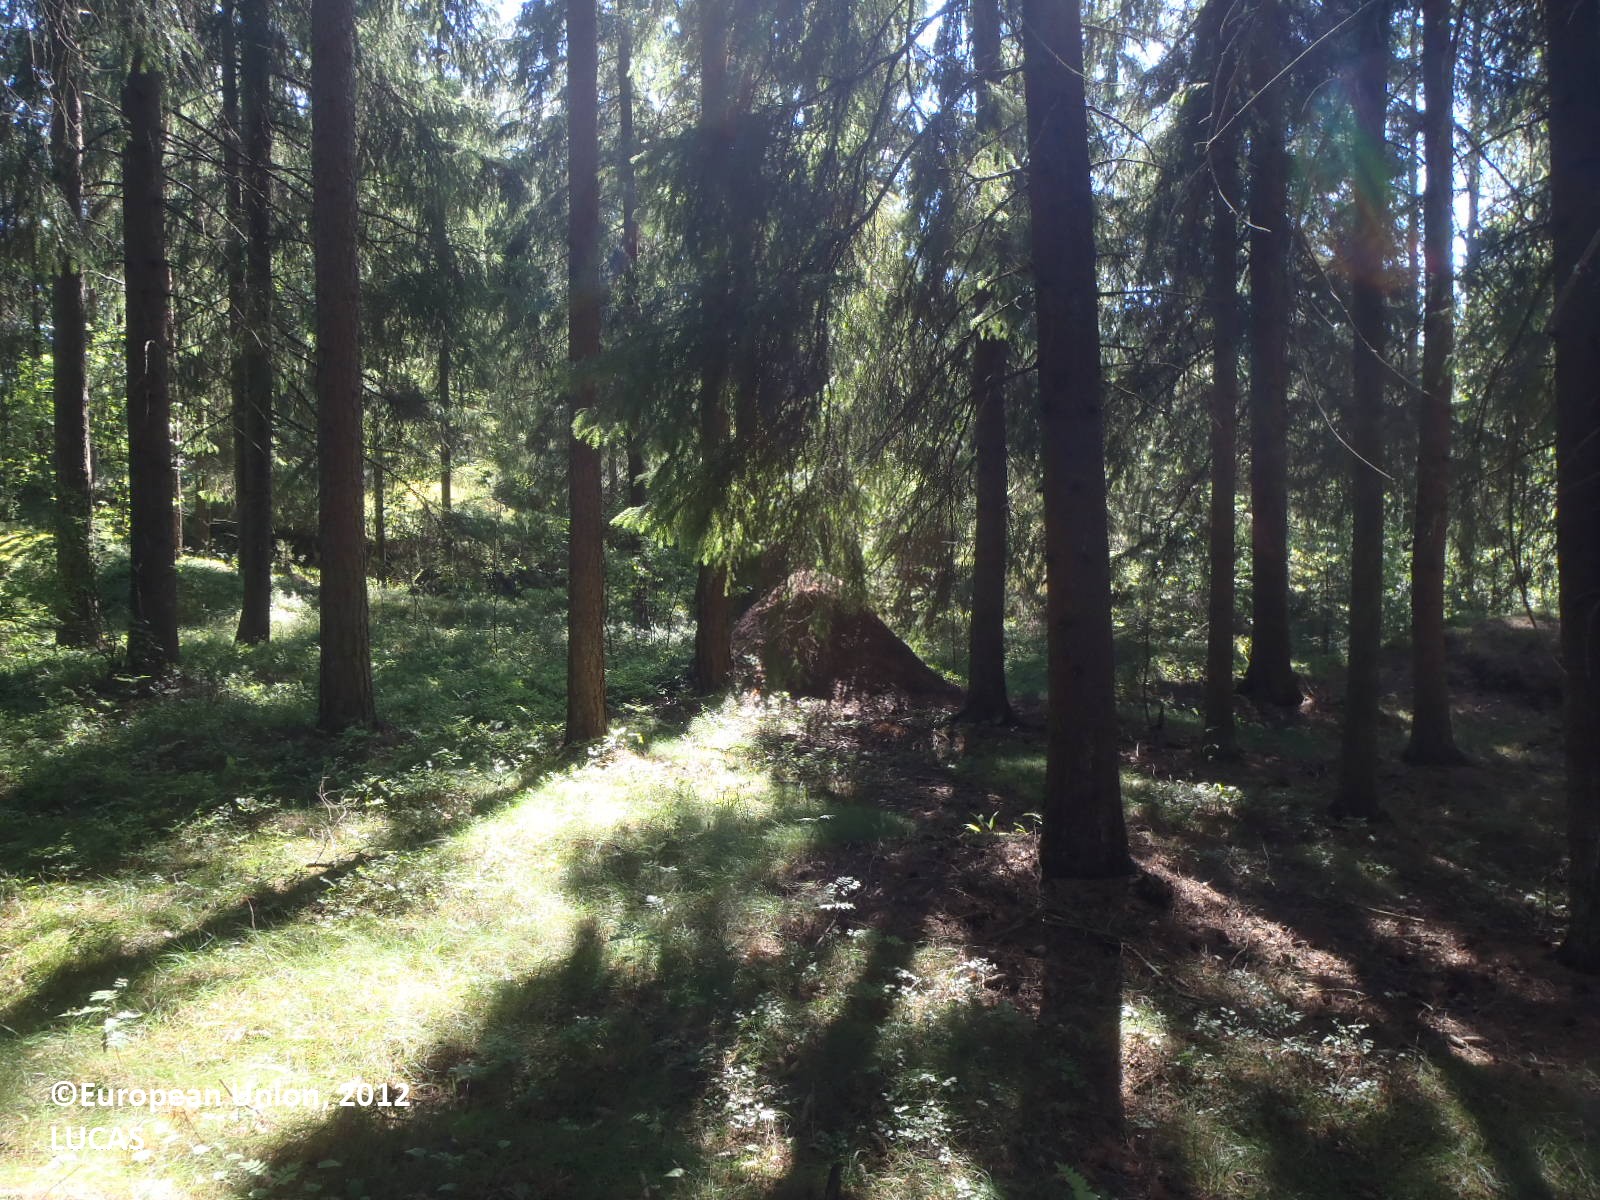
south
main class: Woodland
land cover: Other coniferous woodland
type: boreal forest
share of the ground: > 75 %
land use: Forestry
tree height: > 5 m
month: July
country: FI
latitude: 60.7103
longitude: 21.7309
